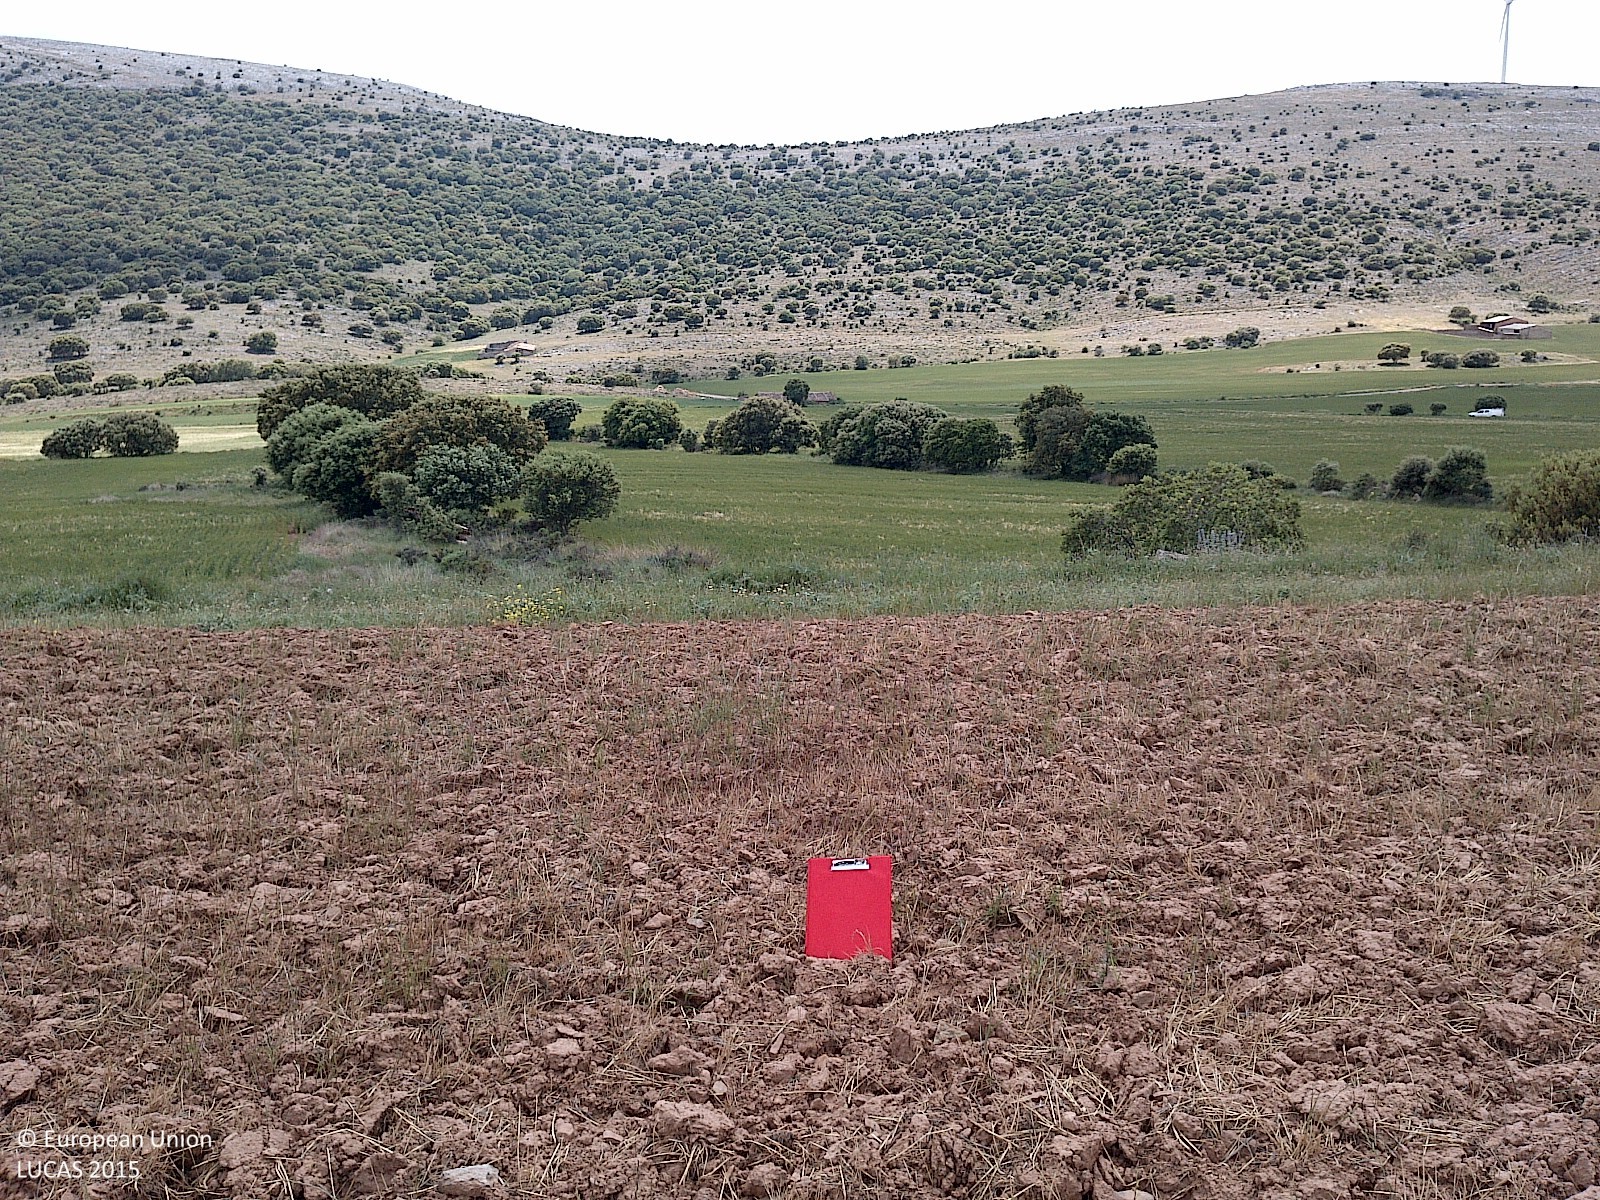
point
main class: Grassland
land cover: Spontaneously vegetated surfaces
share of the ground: 10 - 25 %
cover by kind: unconsolidated bare surface 80 %, herbaceous plants 20 %
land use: Fallow land
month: June
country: ES
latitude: 41.7531
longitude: -2.1692
